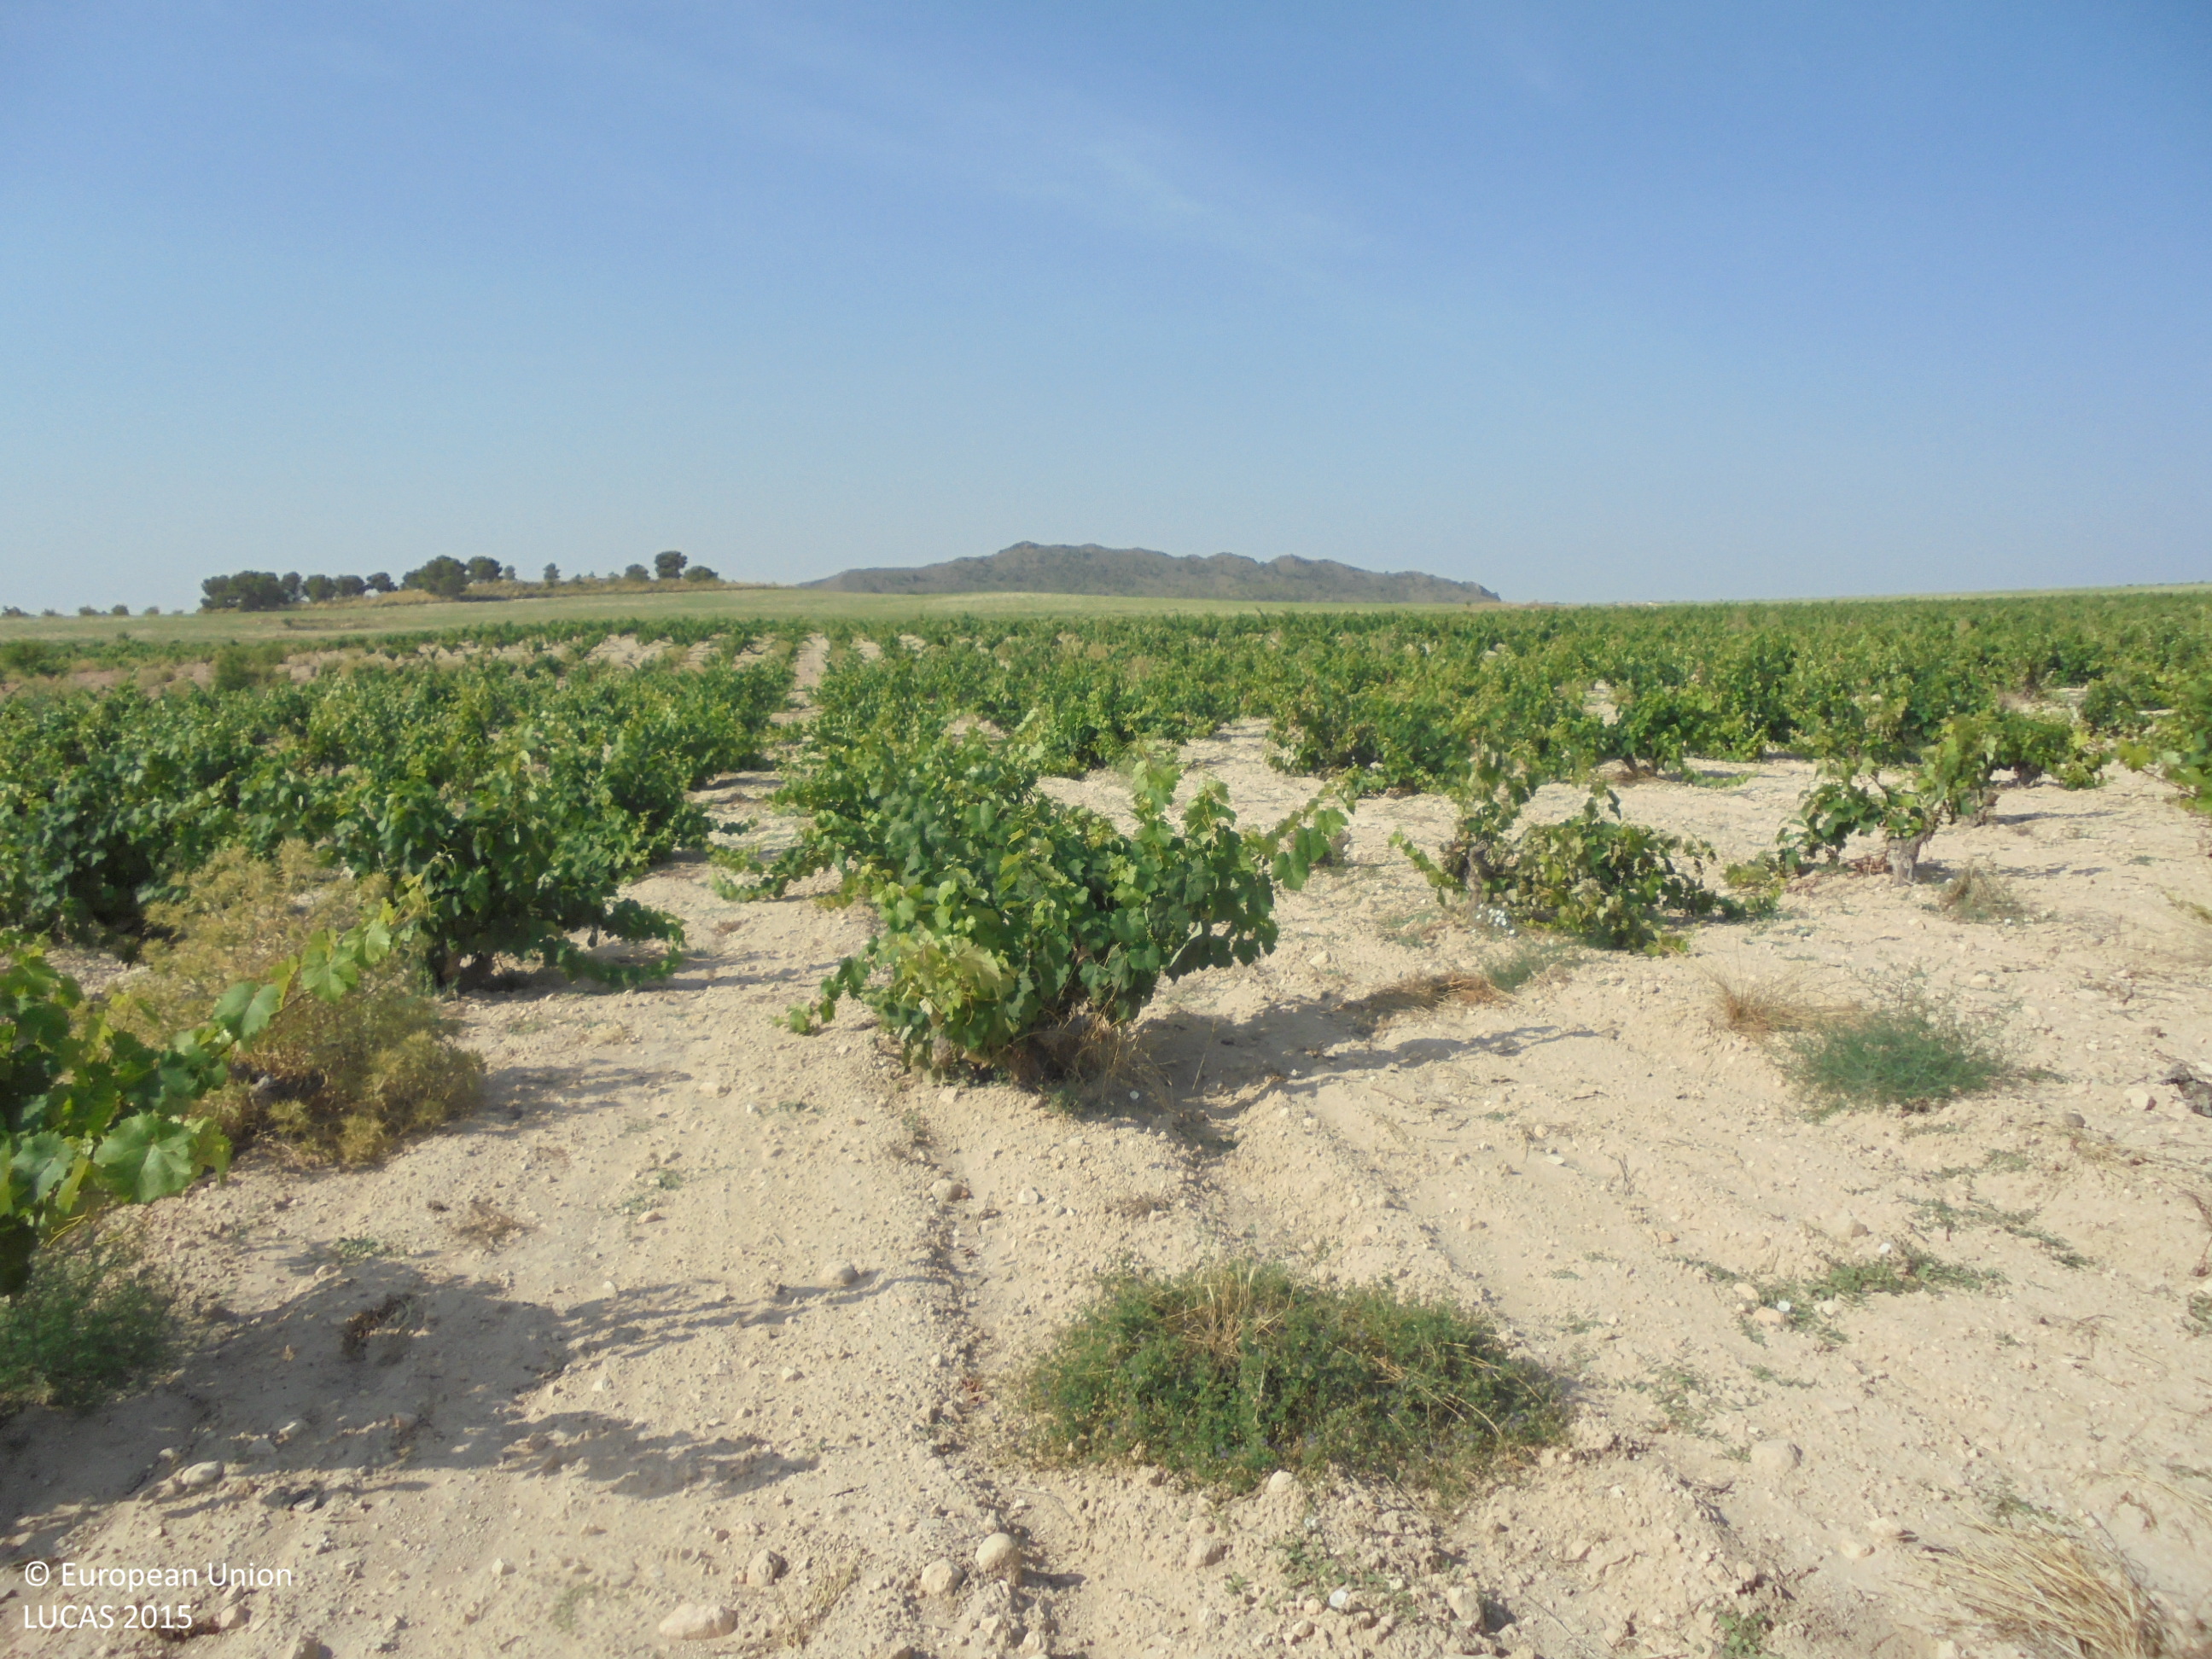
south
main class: Cropland
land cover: Vineyards
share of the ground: 10 - 25 %
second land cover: Spontaneously vegetated surfaces
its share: 10 - 25 %
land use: Agriculture (excluding fallow land and kitchen gardens)
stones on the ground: 10 - 25 %
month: July
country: ES
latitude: 38.6079
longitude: -1.6038
